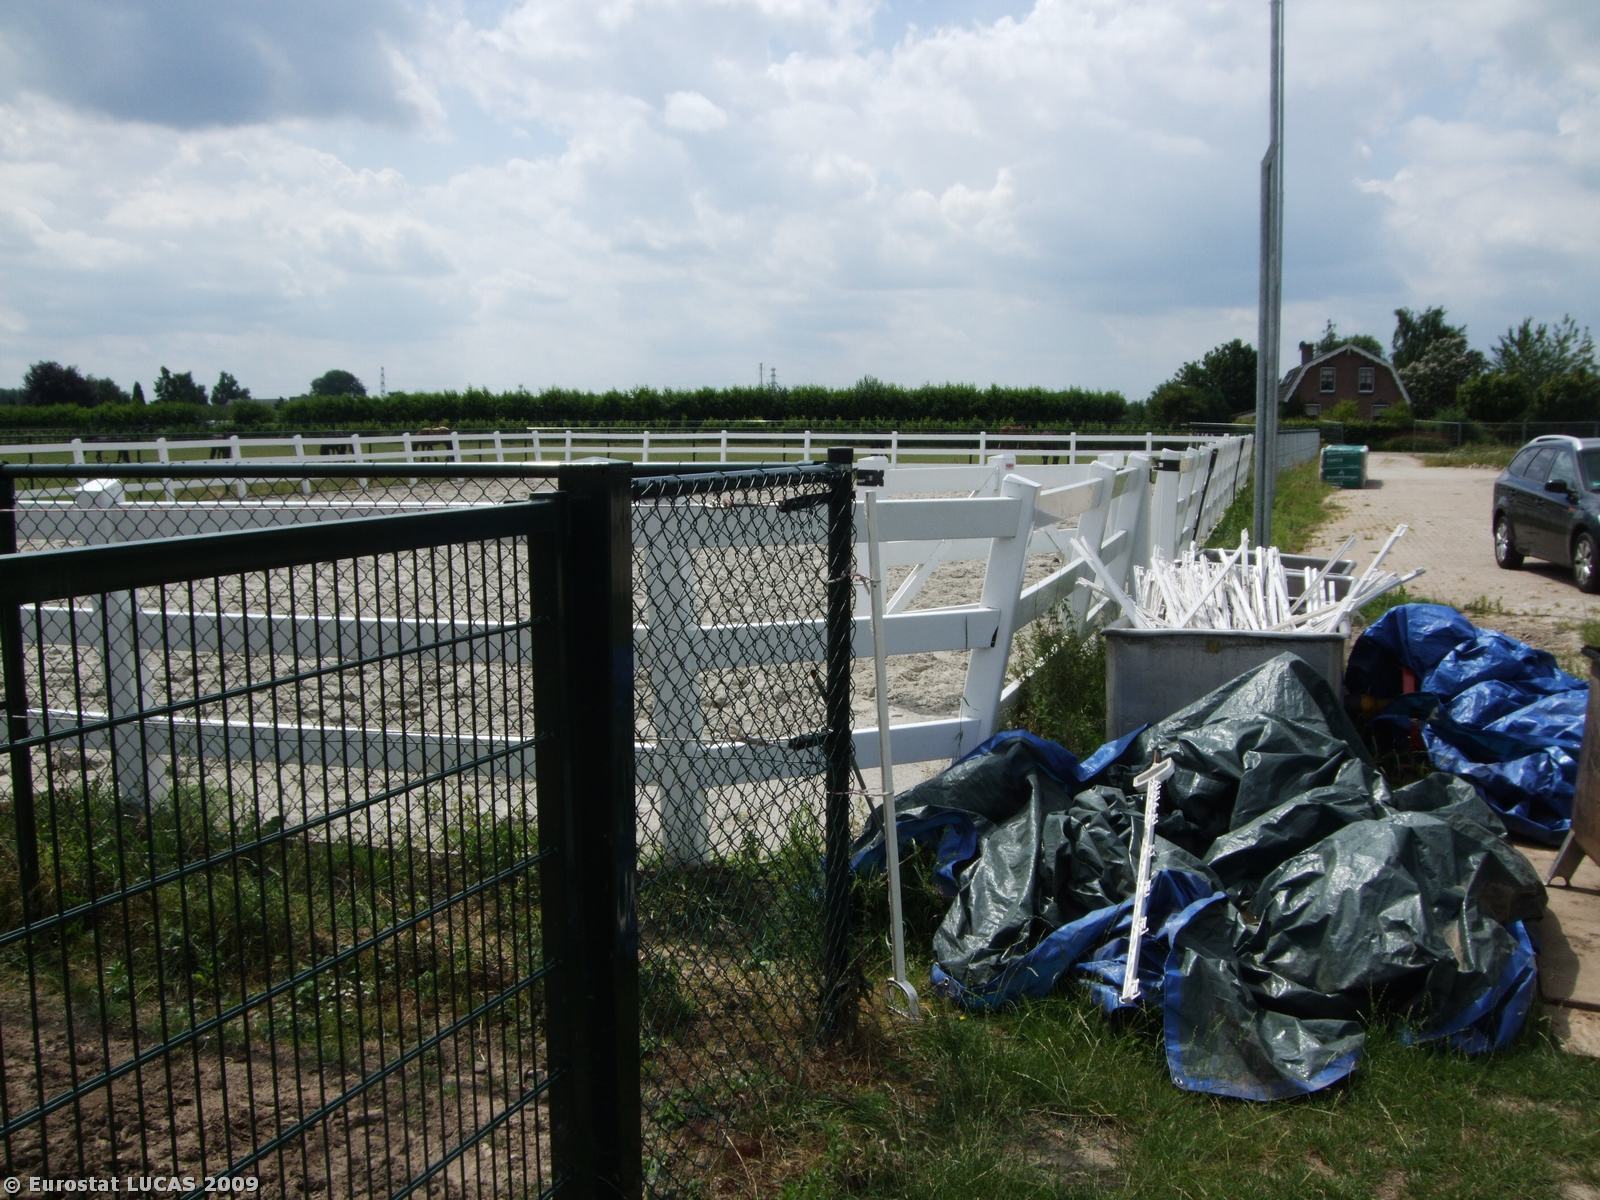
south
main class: Cropland
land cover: Apple fruit
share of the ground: 25 - 50 %
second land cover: Grassland with sparse tree/shrub cover
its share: 50 - 75 %
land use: Agriculture (excluding fallow land and kitchen gardens)
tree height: < 5 m
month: July
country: NL
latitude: 51.9110
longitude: 5.4190
